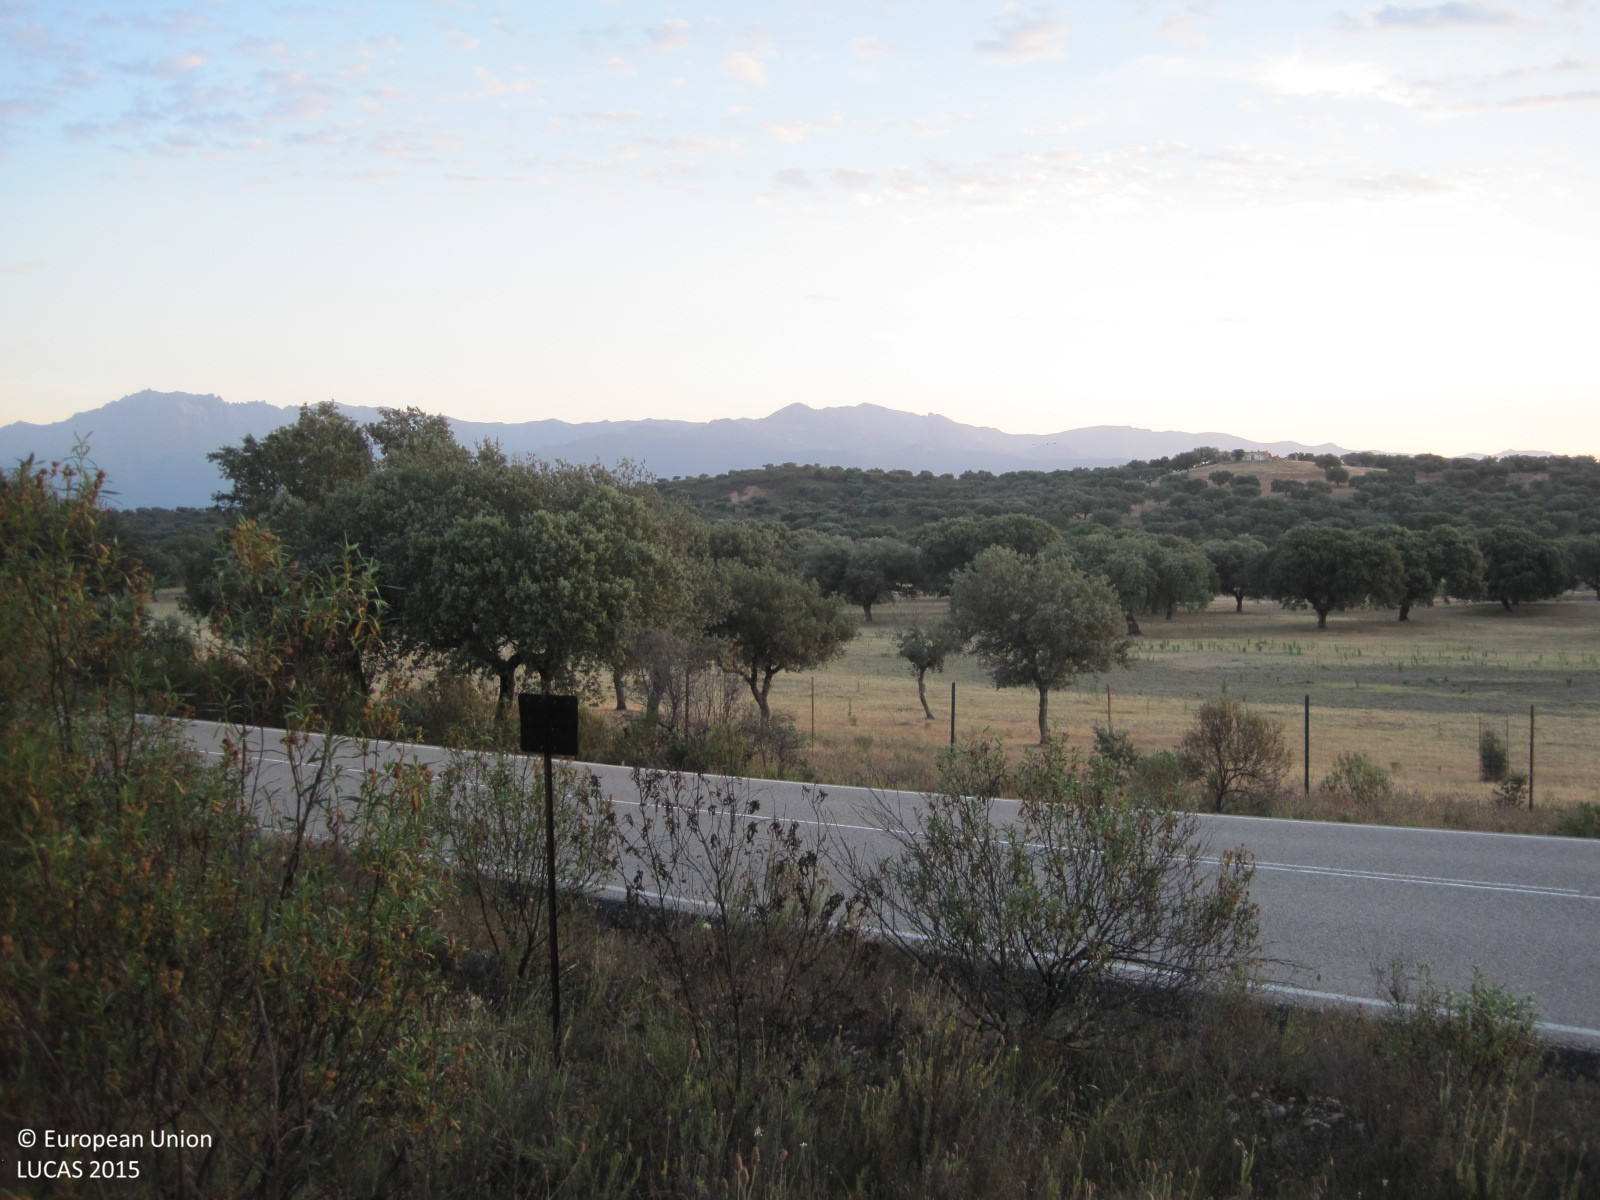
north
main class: Woodland
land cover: Broadleaved woodland
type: broadleaved evergreen forest
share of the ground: > 75 %
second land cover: Shrubland without tree cover
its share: 50 - 75 %
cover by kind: broadleaved forest trees 75 %, shrubs 20 %, herbaceous plants 5 %
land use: Forestry
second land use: Agriculture (excluding fallow land and kitchen gardens)
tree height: < 5 m
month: June
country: ES
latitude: 40.0544
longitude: -5.1651
